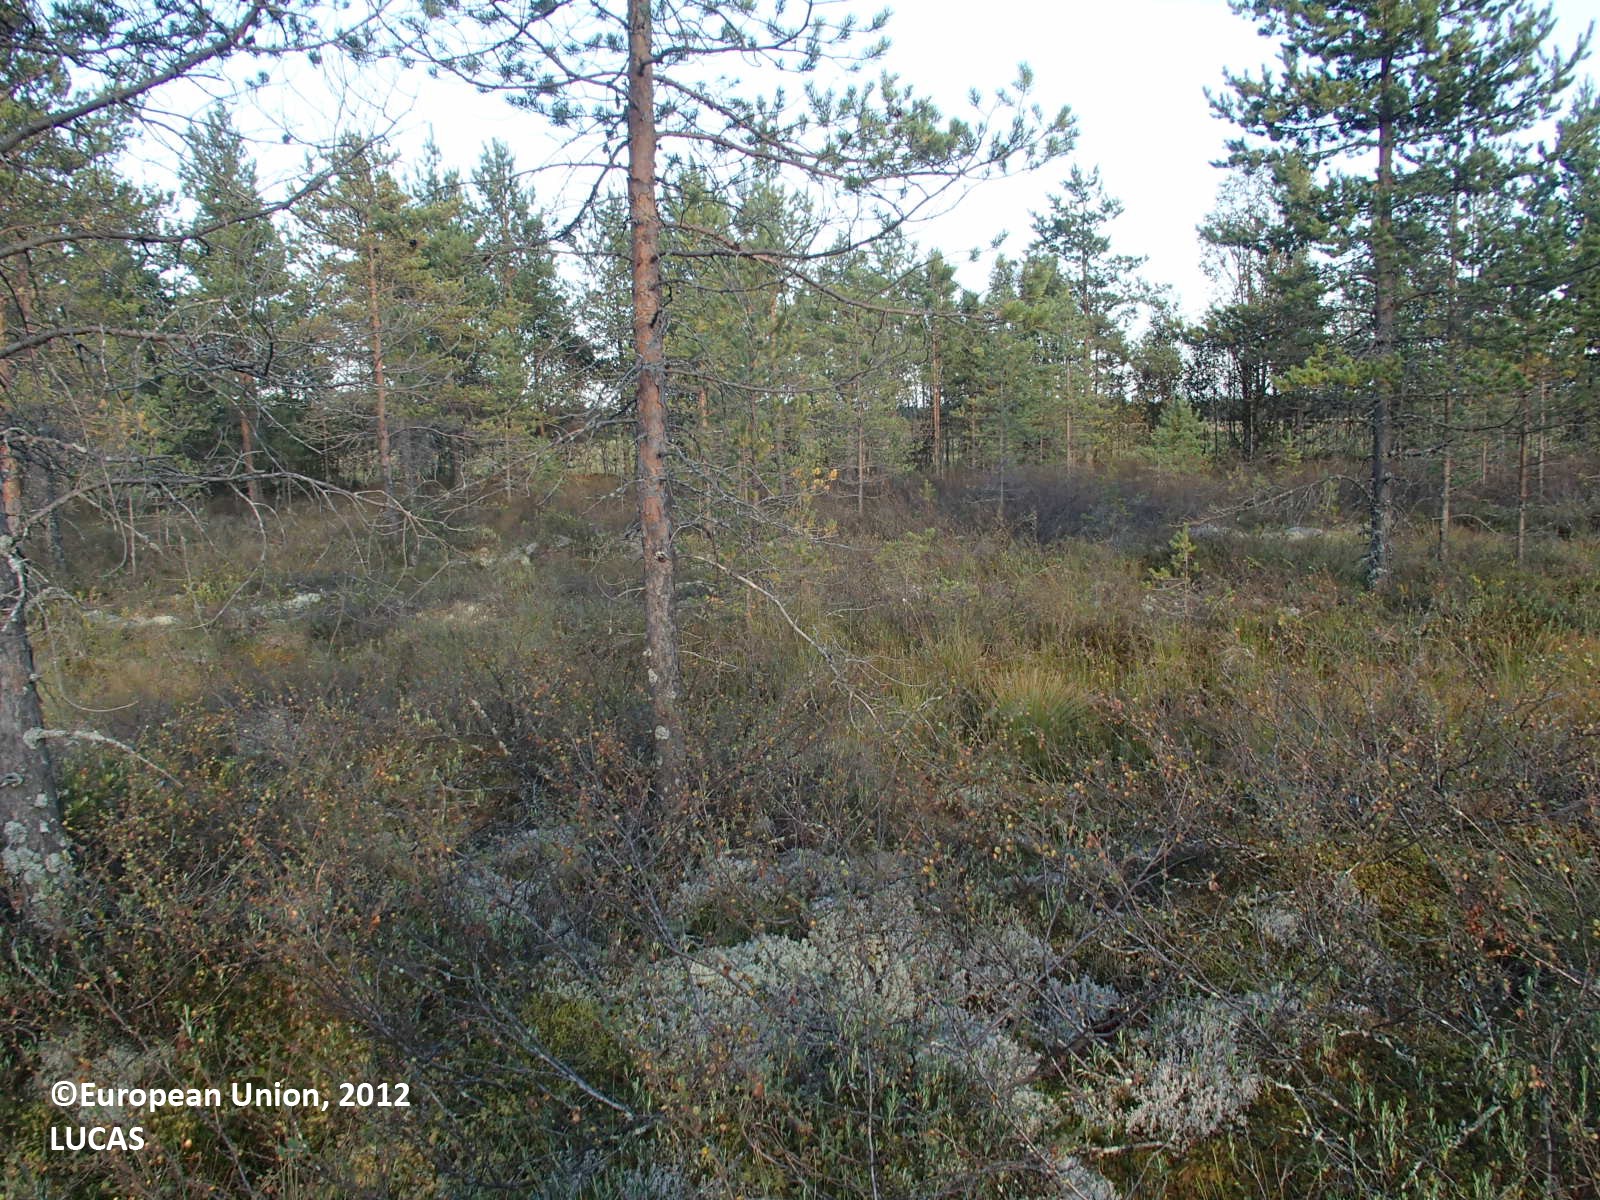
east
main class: Woodland
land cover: Pine dominated coniferous woodland
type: boreal forest
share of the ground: 25 - 50 %
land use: Forestry
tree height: < 5 m
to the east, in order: Pine dominated coniferous woodland; Pine dominated mixed woodland; Ditches and canals; Grass margins; Temporary grasslands; Ditches and canals; Temporary grasslands; Ditches and canals; Temporary grasslands; Ditches and canals; Temporary grasslands; Ditches and canals; Temporary grasslands; Ditches and canals; Temporary grasslands; Ditches and canals; Temporary grasslands; Ditches and canals; Temporary grasslands; Ditches and canals; Temporary grasslands; Ditches and canals; Temporary grasslands; Ditches and canals; Temporary grasslands; Ditches and canals; Temporary grasslands
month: August
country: FI
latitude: 63.9438
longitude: 26.0458
